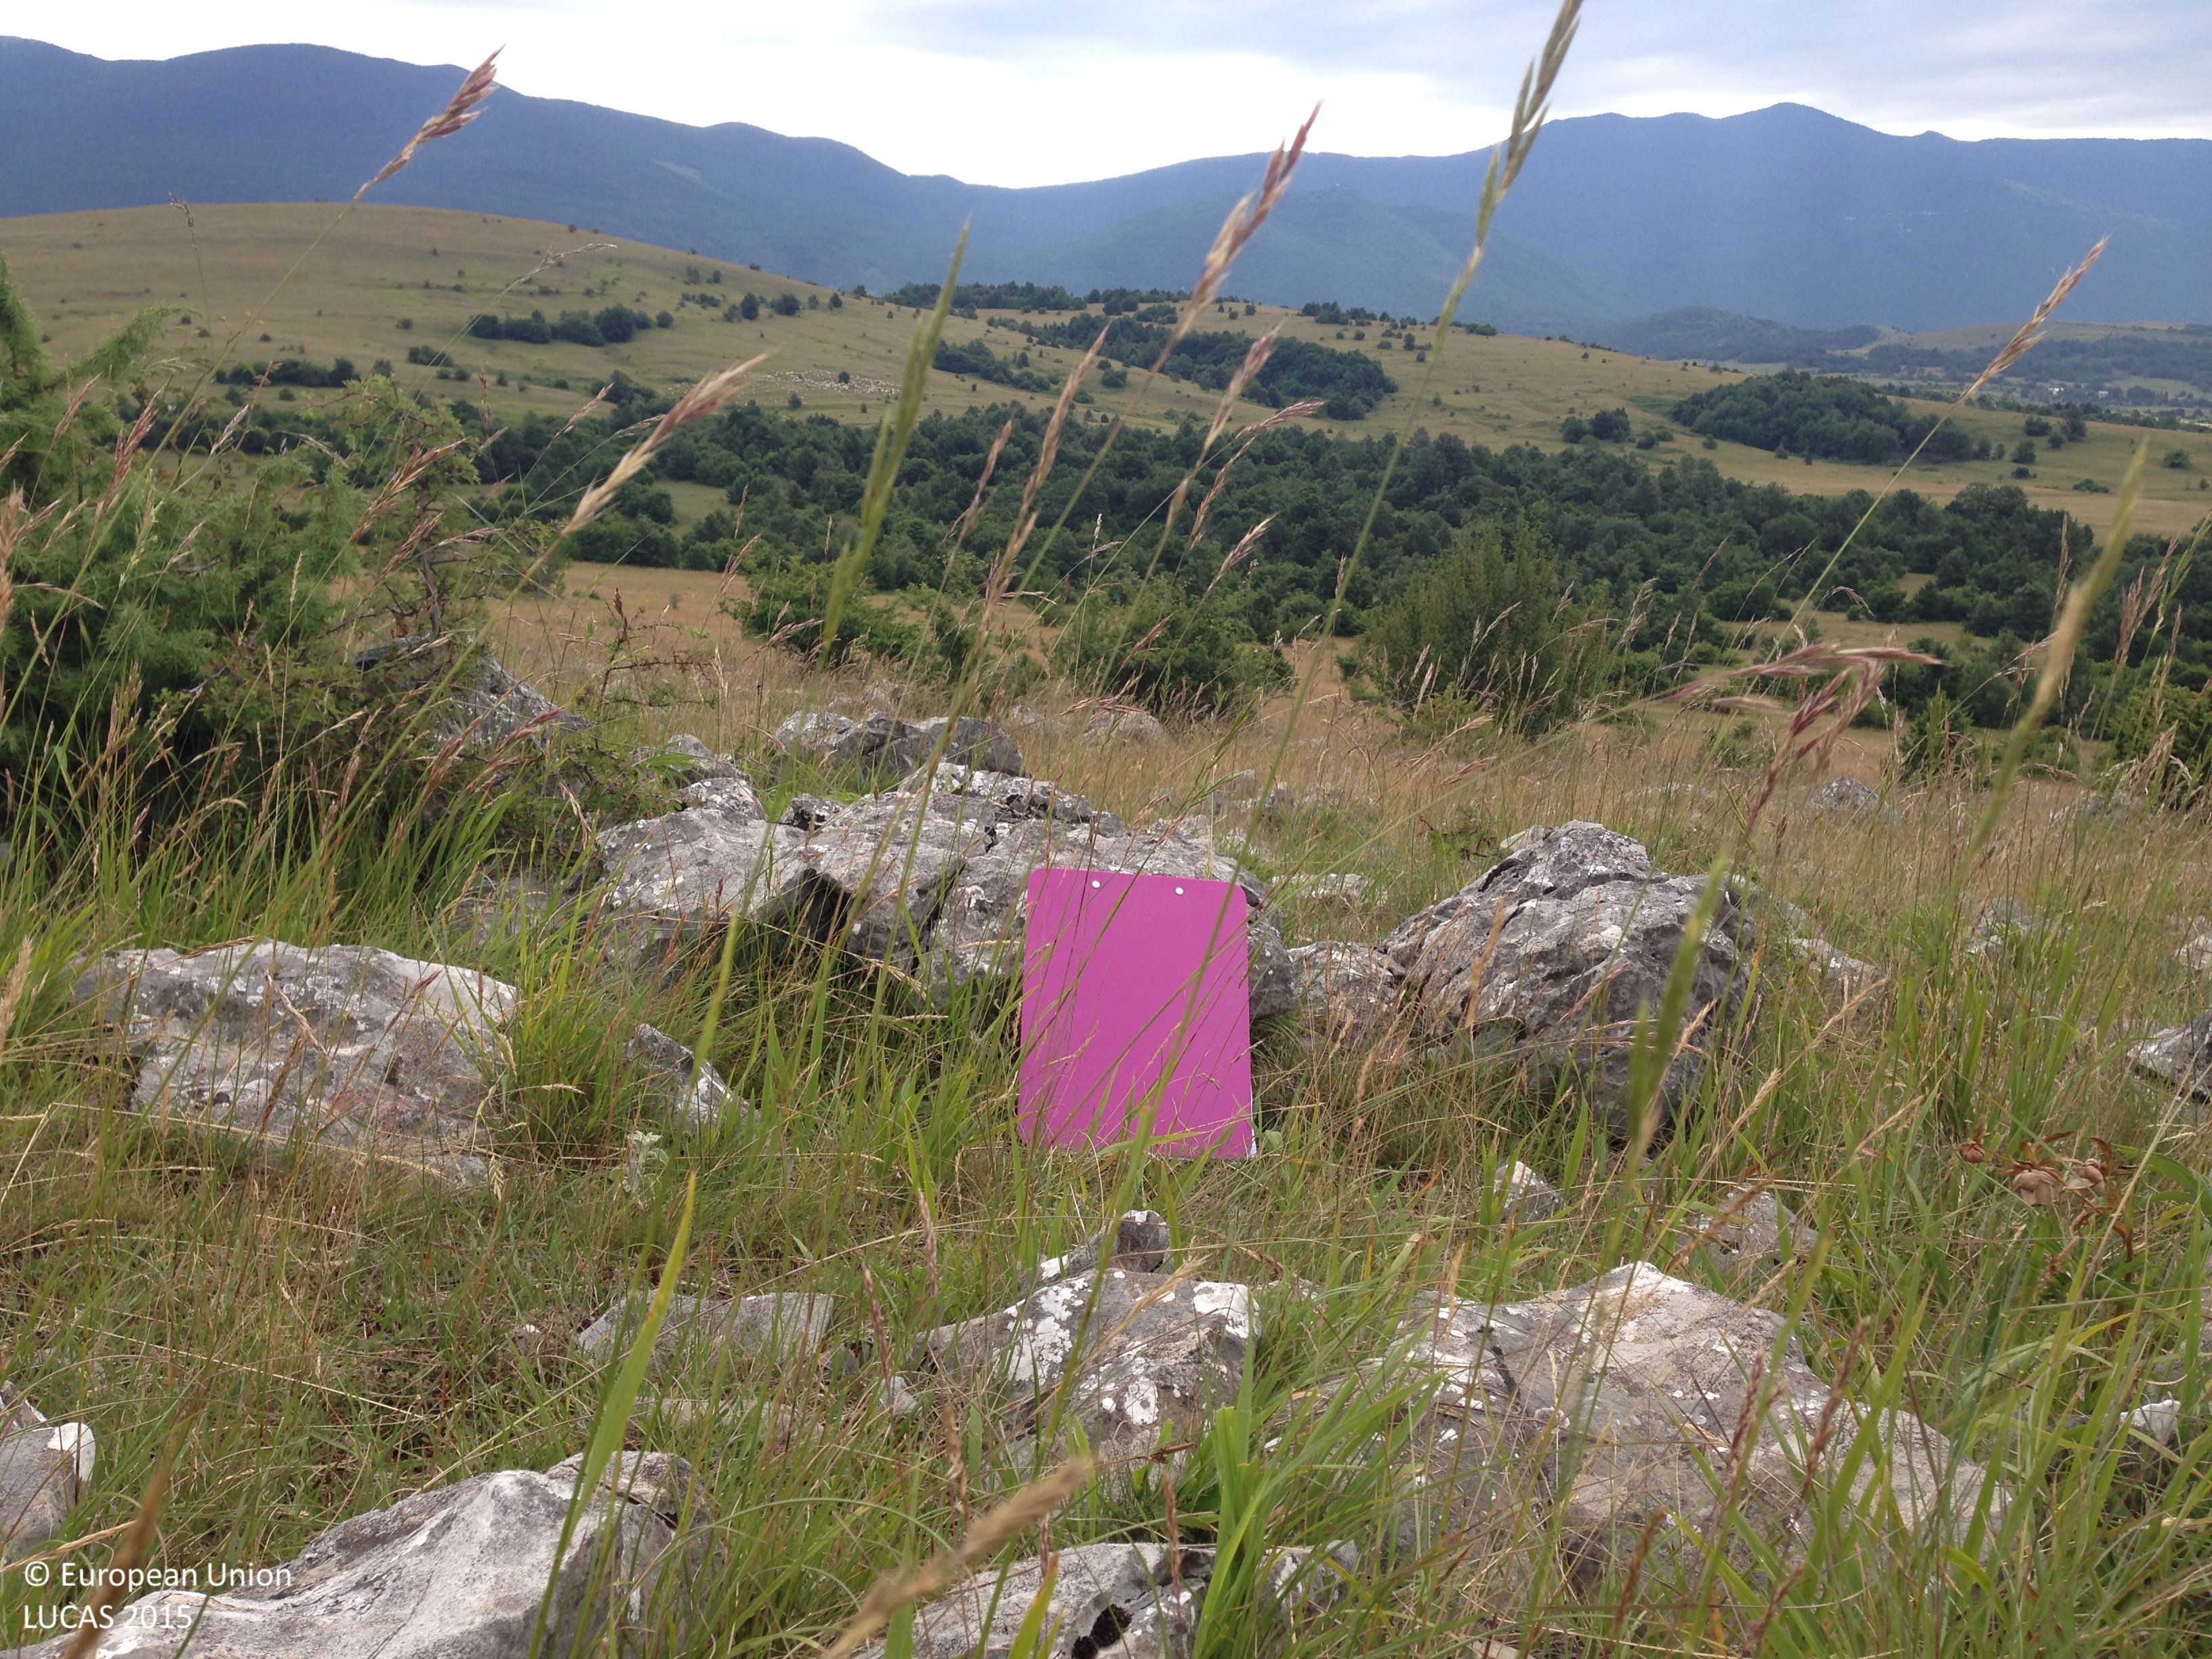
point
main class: Shrubland
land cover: Shrubland with sparse tree cover
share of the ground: 10 - 25 %
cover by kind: herbaceous plants 40 %, consolidated bare surface 25 %, shrubs 20 %, unconsolidated bare surface 10 %, coniferous forest trees 5 %
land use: Agriculture (excluding fallow land and kitchen gardens)
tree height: < 5 m
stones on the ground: < 10 %
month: June
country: HR
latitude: 44.7173
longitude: 15.7129
